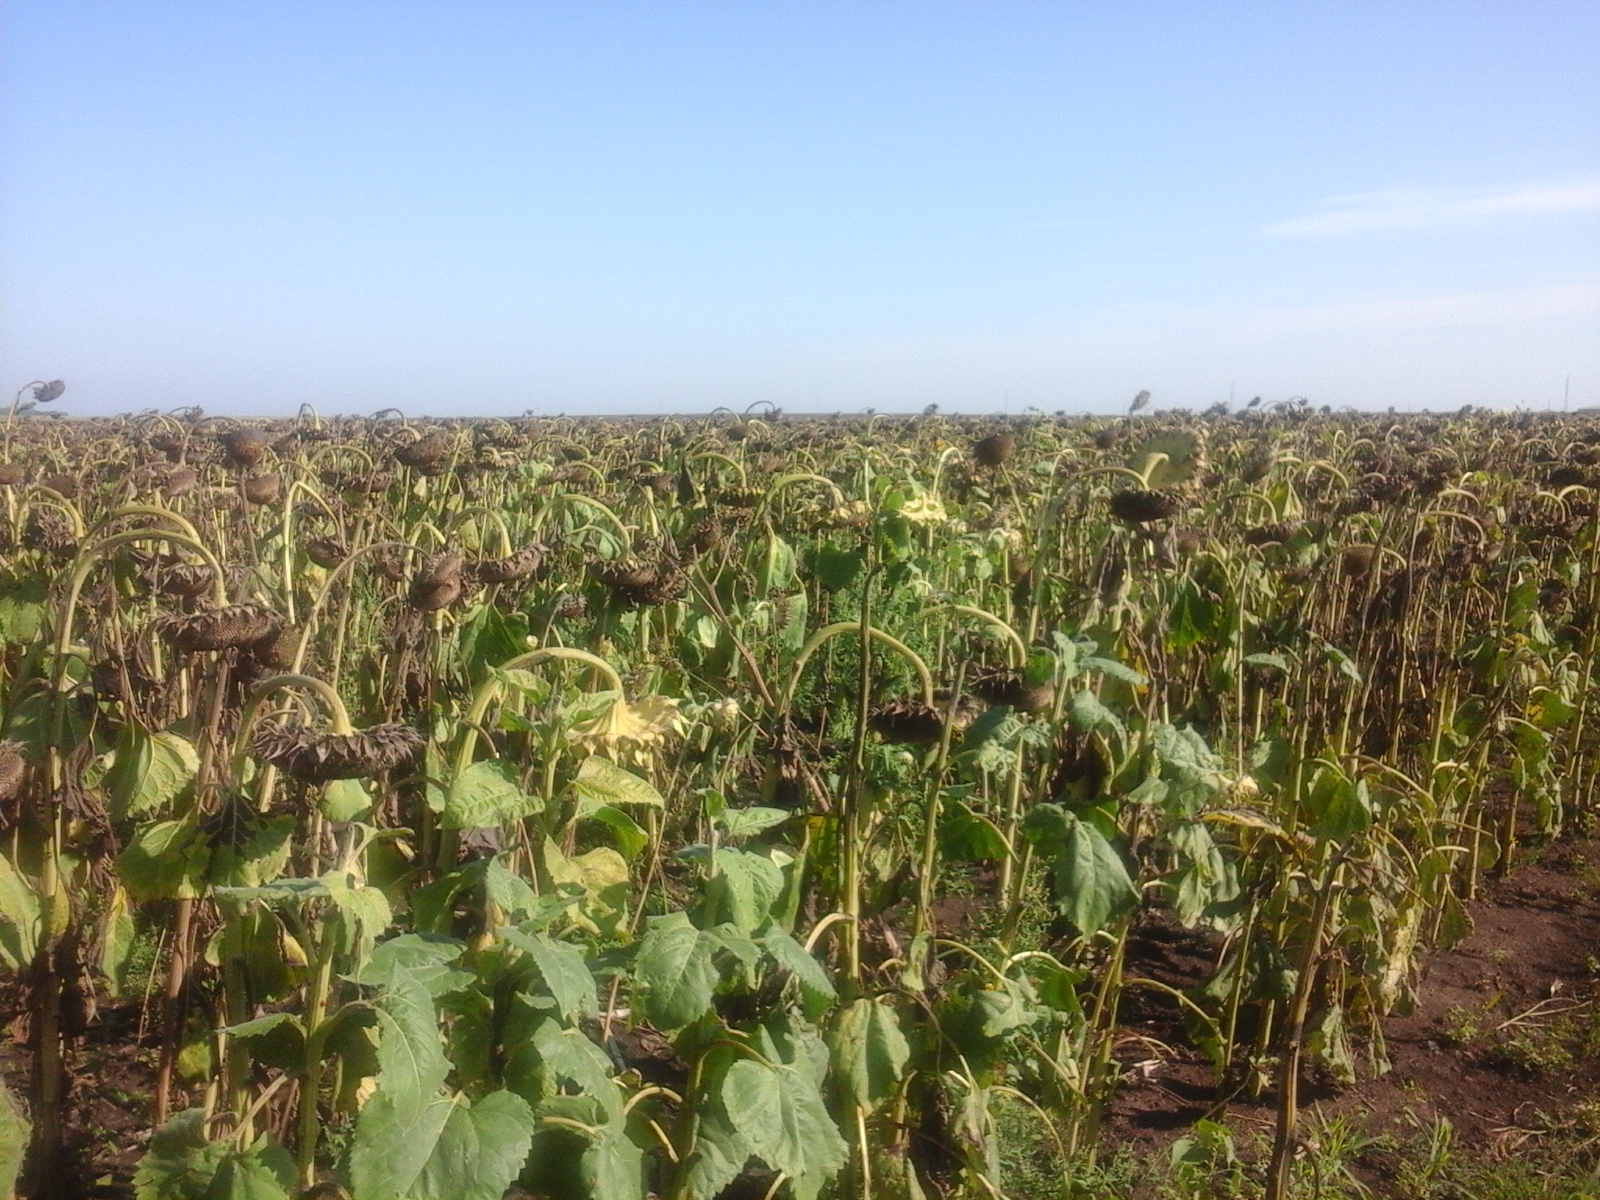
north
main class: Cropland
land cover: Sunflower
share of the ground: > 75 %
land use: Agriculture (excluding fallow land and kitchen gardens)
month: August
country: RO
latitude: 45.8657
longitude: 21.0687
